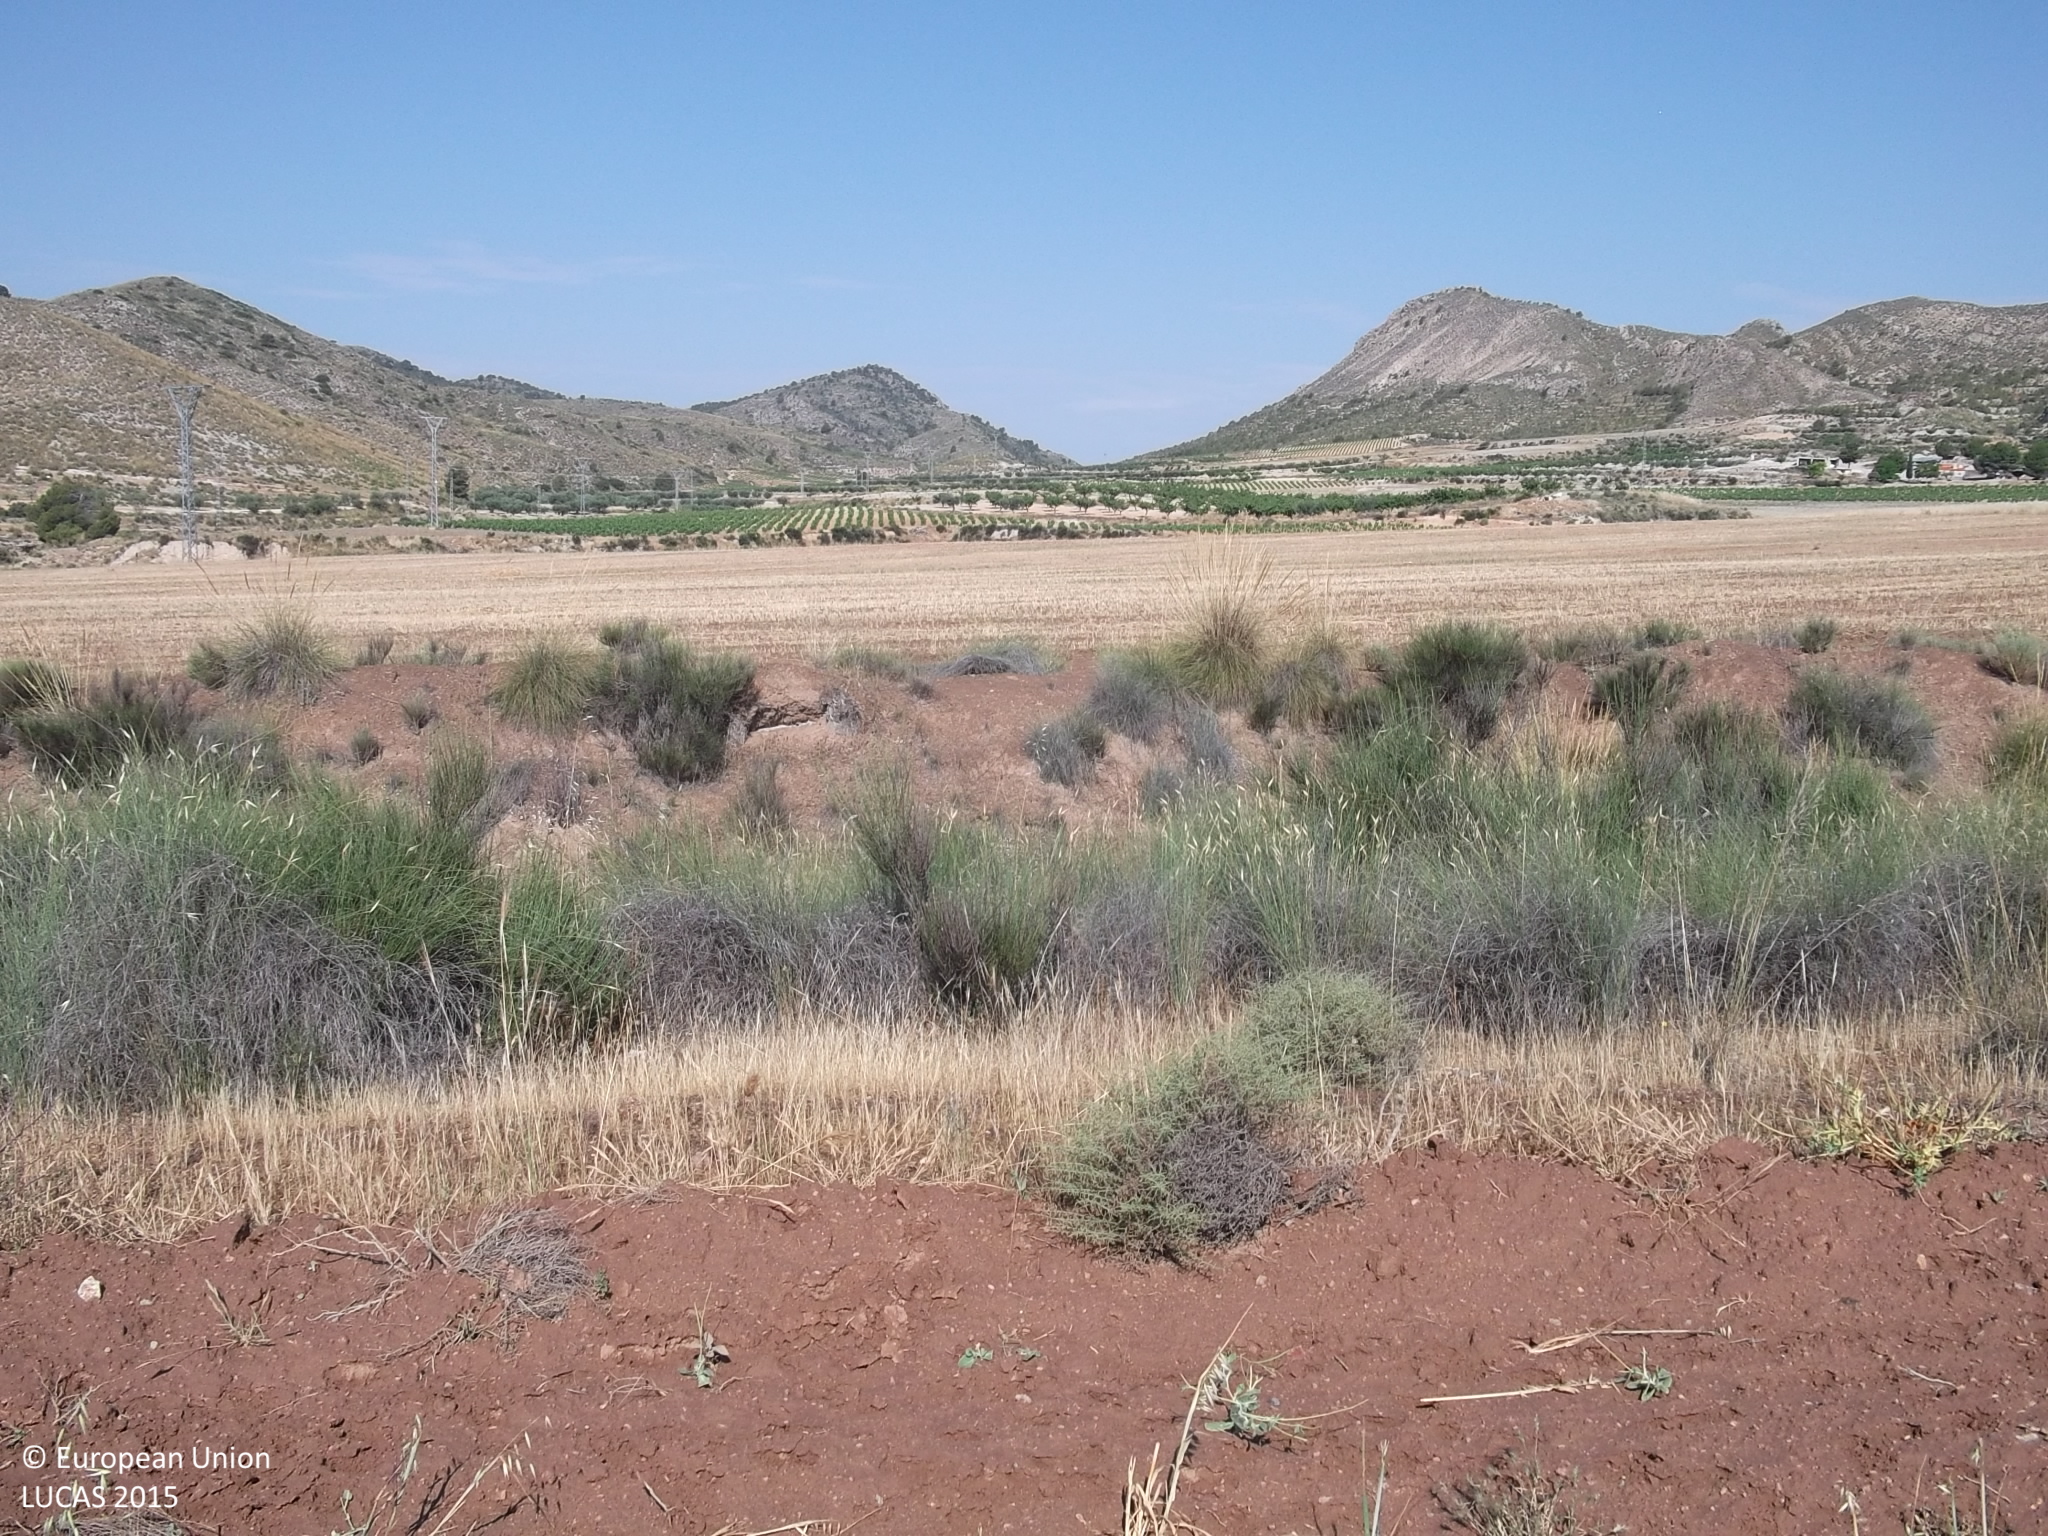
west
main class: Cropland
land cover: Oats
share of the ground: > 75 %
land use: Agriculture (excluding fallow land and kitchen gardens)
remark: Harvested field
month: June
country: ES
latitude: 38.4712
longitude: -1.3725
